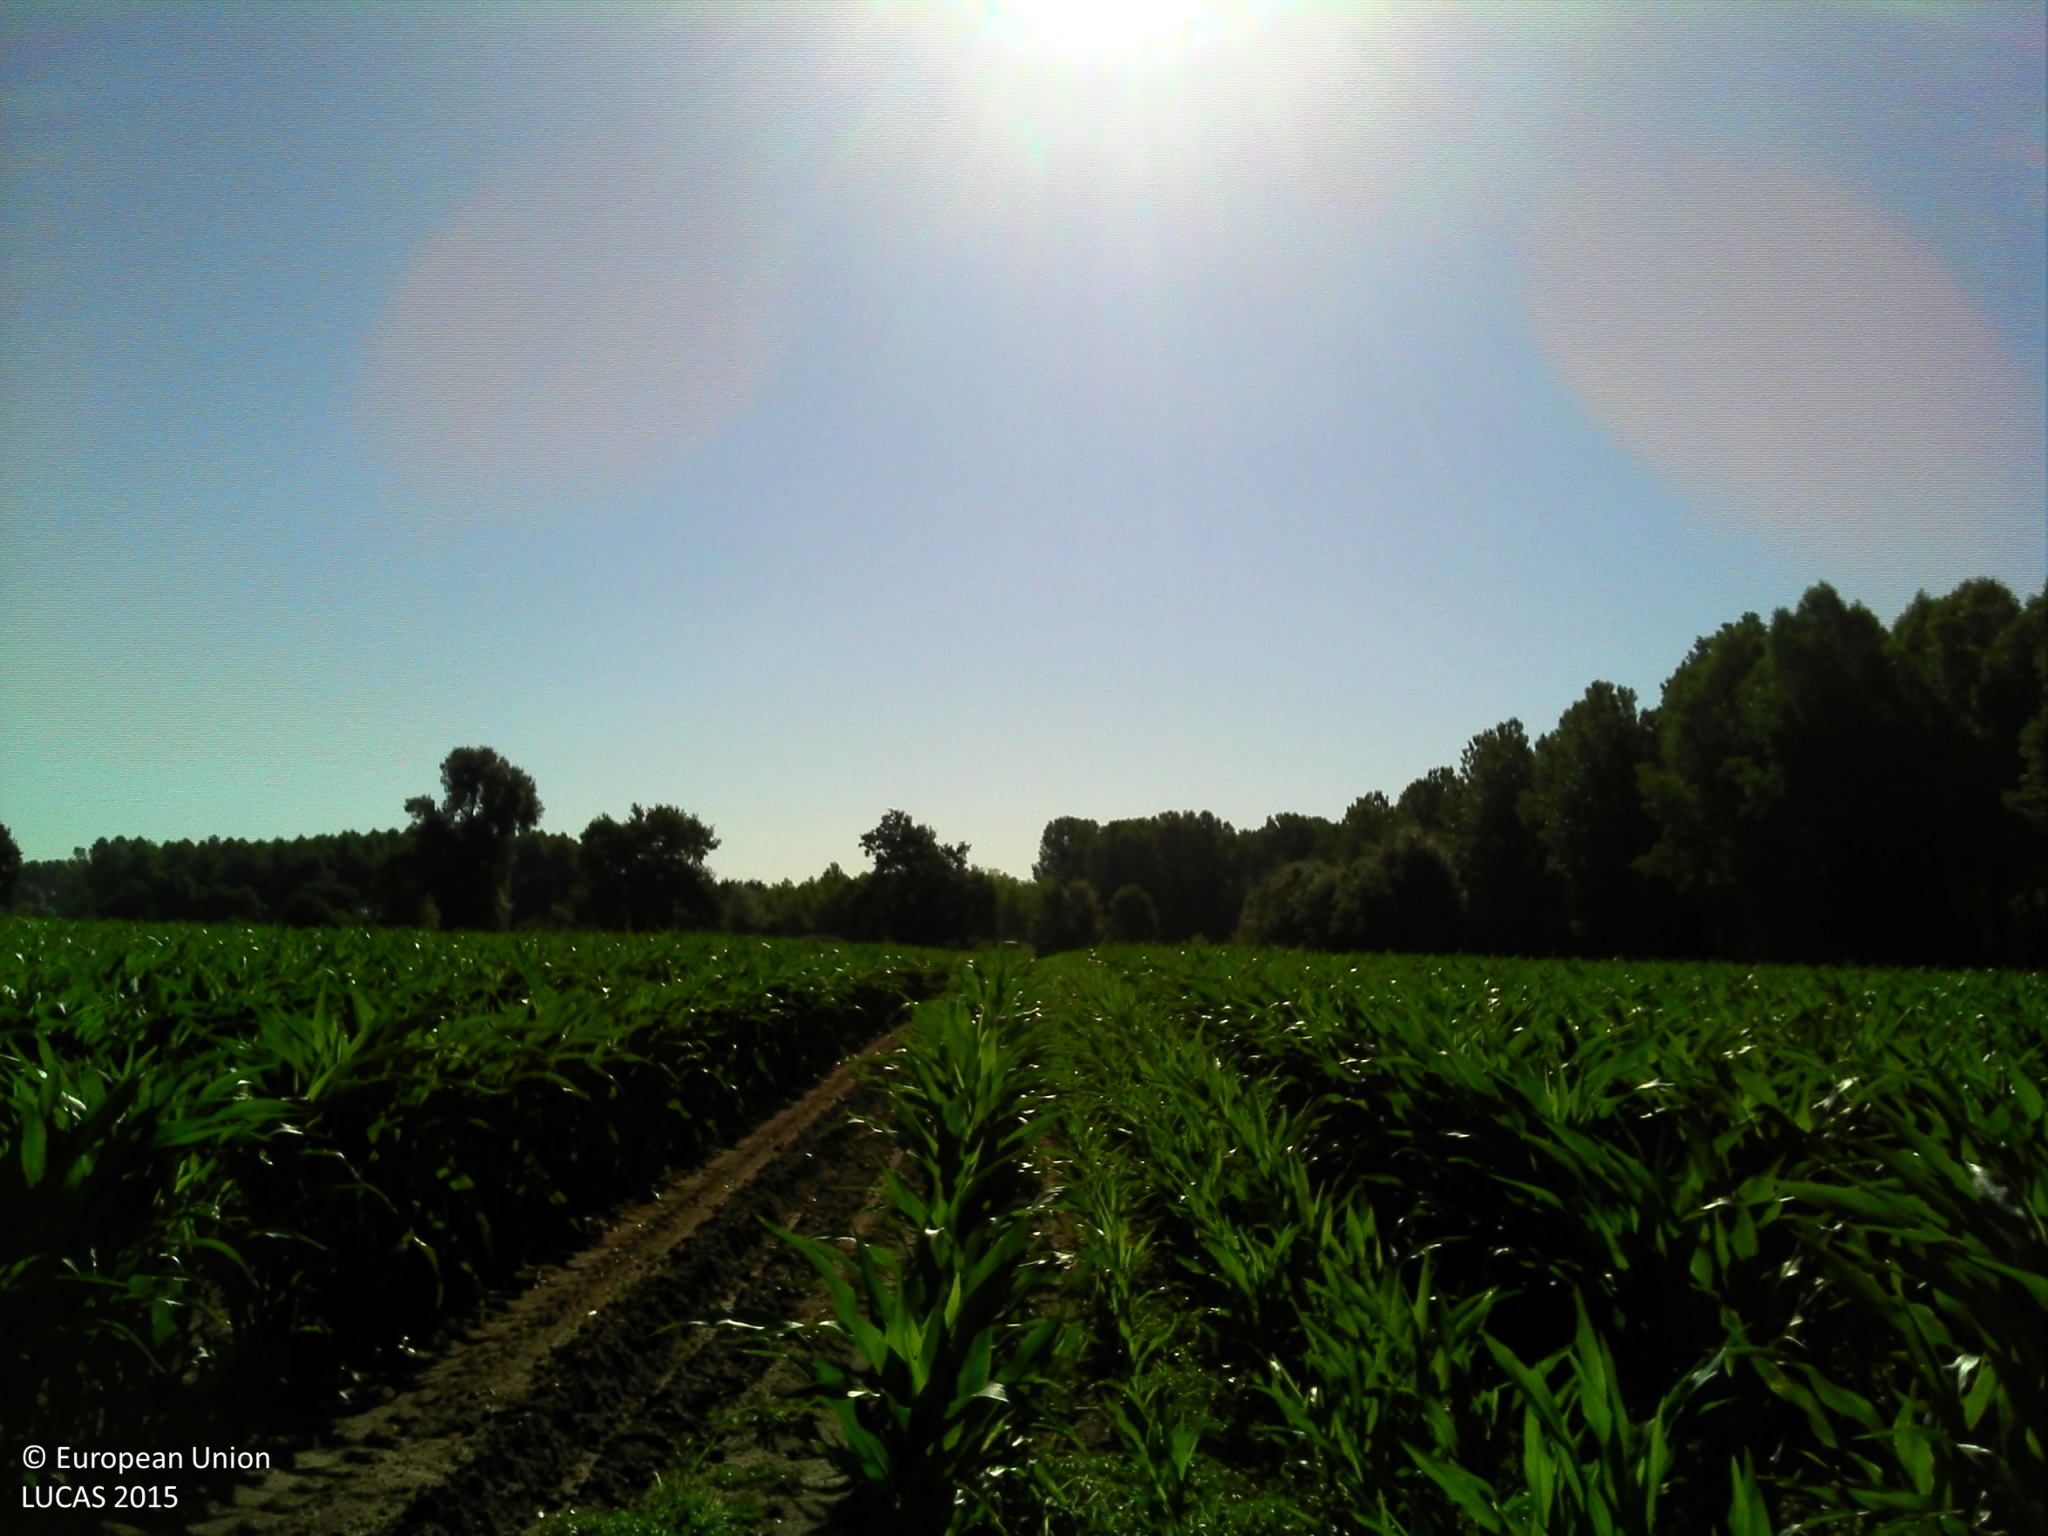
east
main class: Cropland
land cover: Maize
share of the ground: > 75 %
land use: Agriculture (excluding fallow land and kitchen gardens)
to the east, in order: Maize; Grass margins; Lines of trees; Tracks; Grass margins; Electric lines; Managed hedges; Grassland without tree/shrub cover
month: July
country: FR
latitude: 47.6628
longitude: 0.2414
